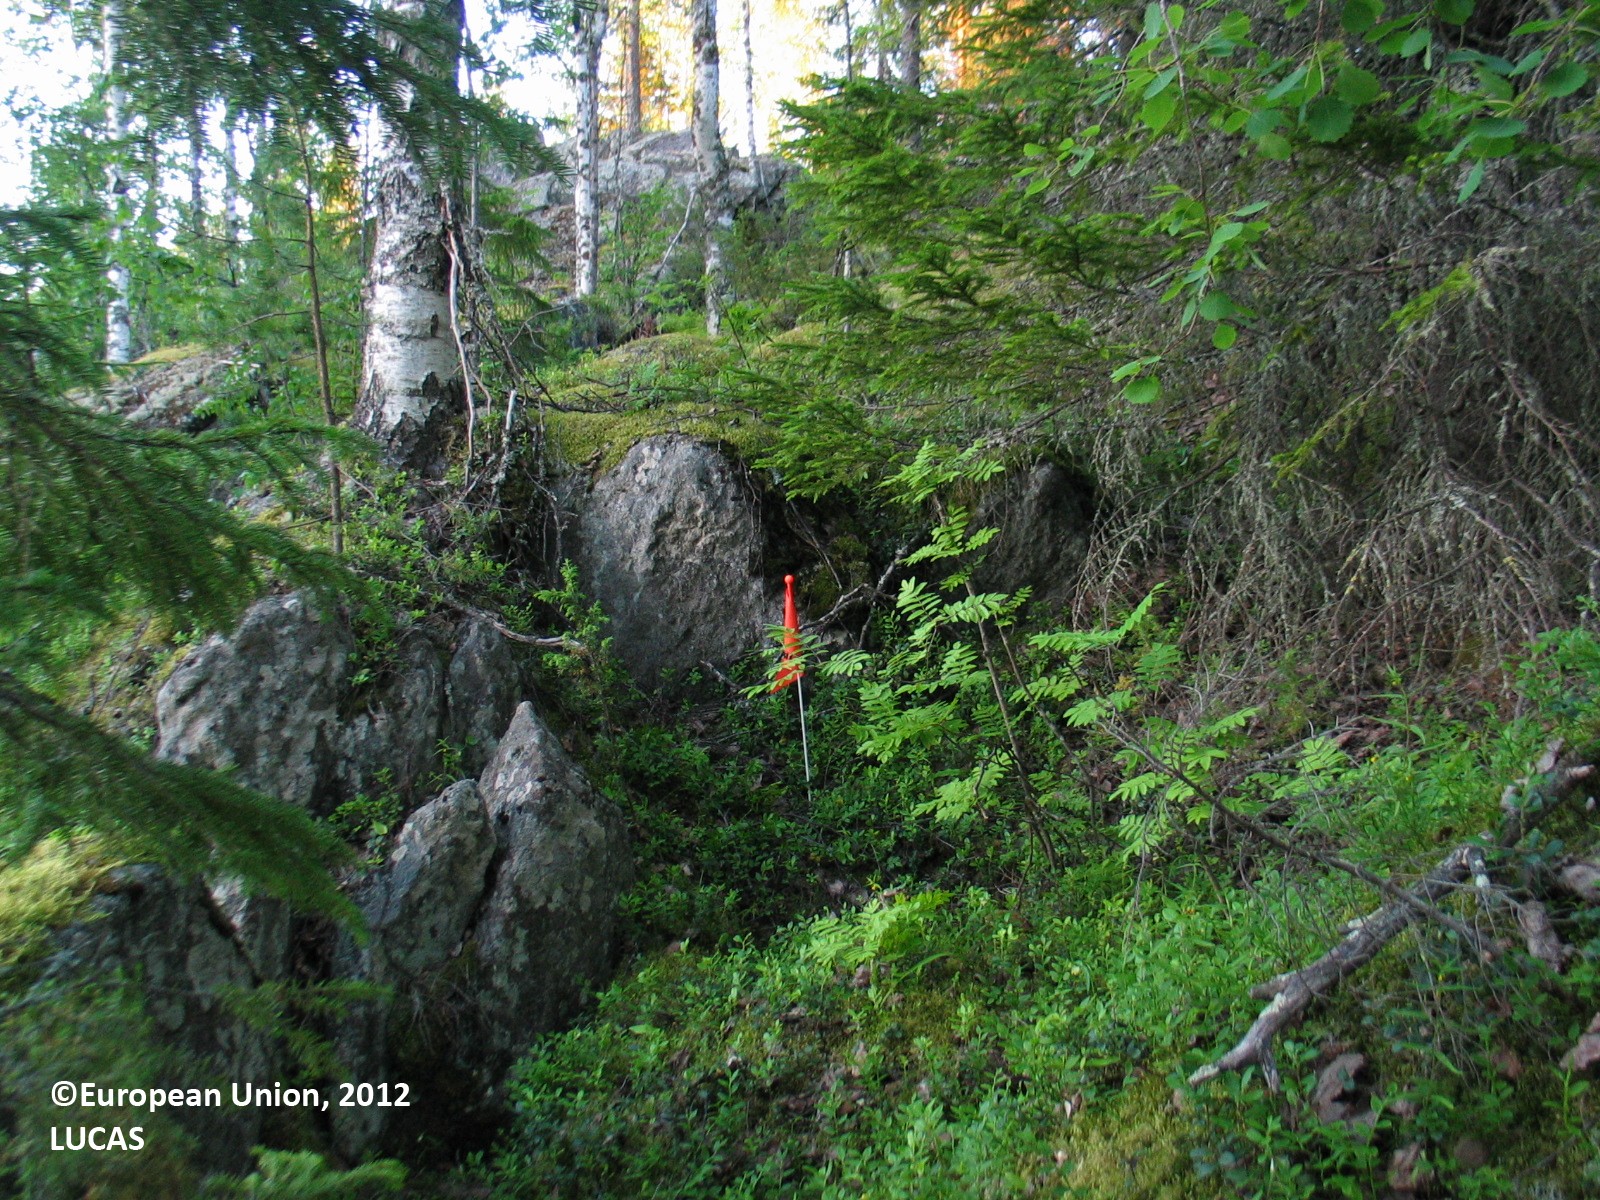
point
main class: Woodland
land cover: Other mixed woodland
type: boreal forest
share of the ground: 25 - 50 %
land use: Forestry
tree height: > 5 m
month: July
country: FI
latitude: 65.8960
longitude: 25.0059
